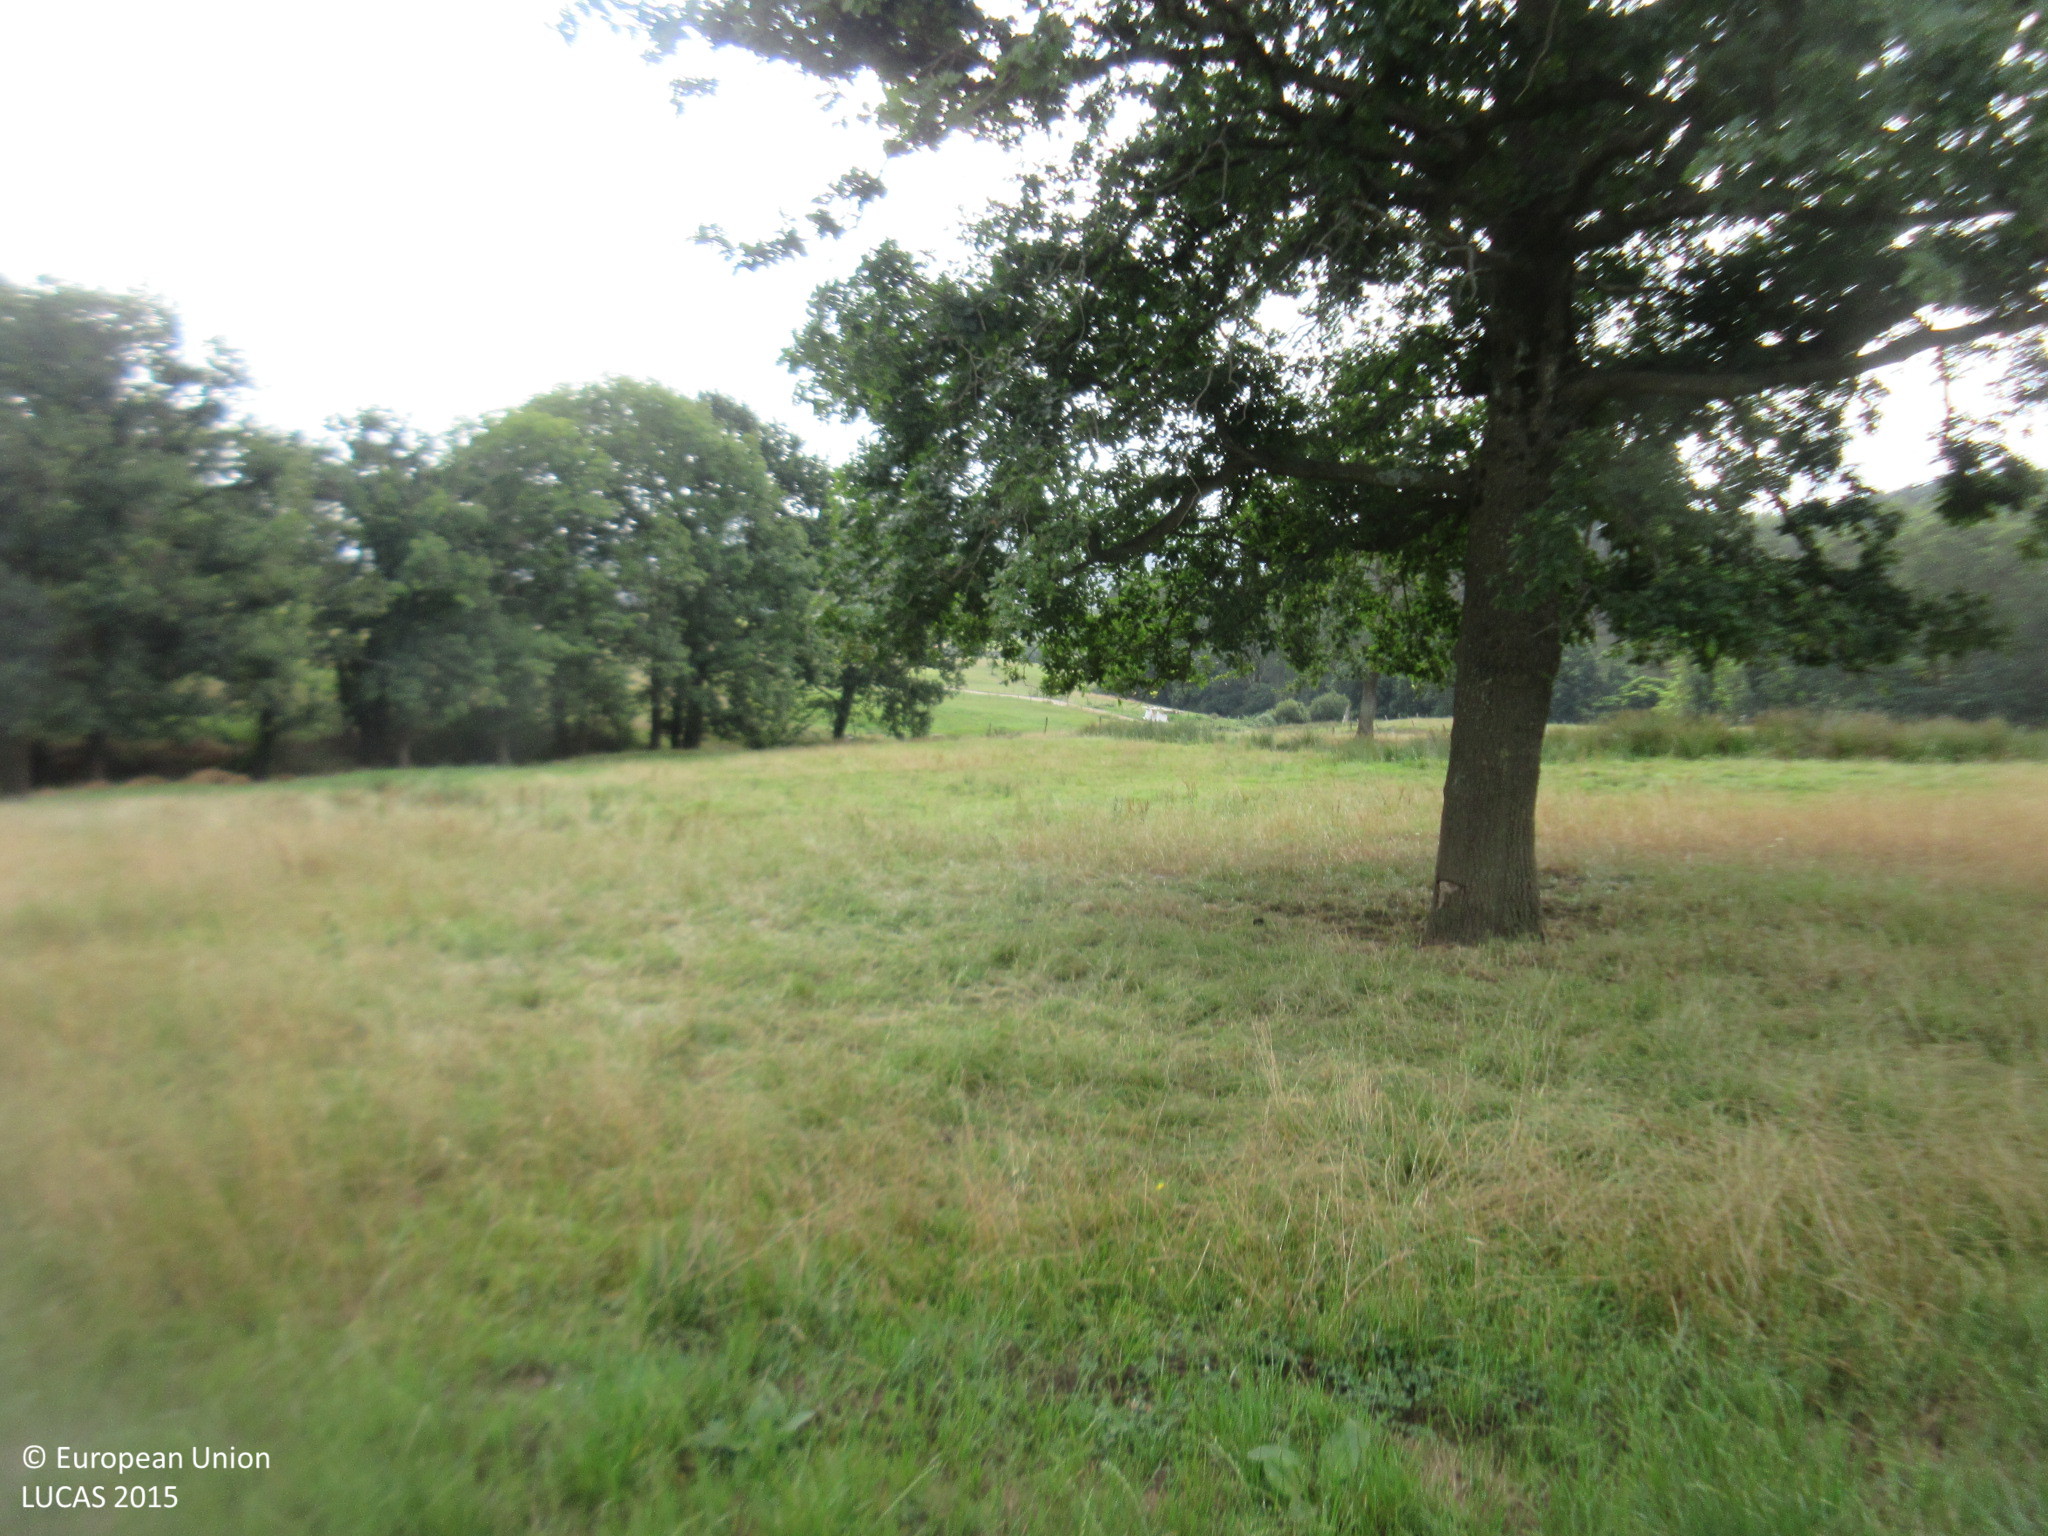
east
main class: Cropland
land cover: Temporary grasslands
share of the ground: > 75 %
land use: Agriculture (excluding fallow land and kitchen gardens)
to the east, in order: Temporary grasslands; Grassland without tree/shrub cover; Groves; Rivers and streams; Grassland without tree/shrub cover; Fences; Grassland without tree/shrub cover; Fences; Grassland without tree/shrub cover; Fences; Grassland without tree/shrub cover
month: July
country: ES
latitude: 43.3409
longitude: -4.0023
